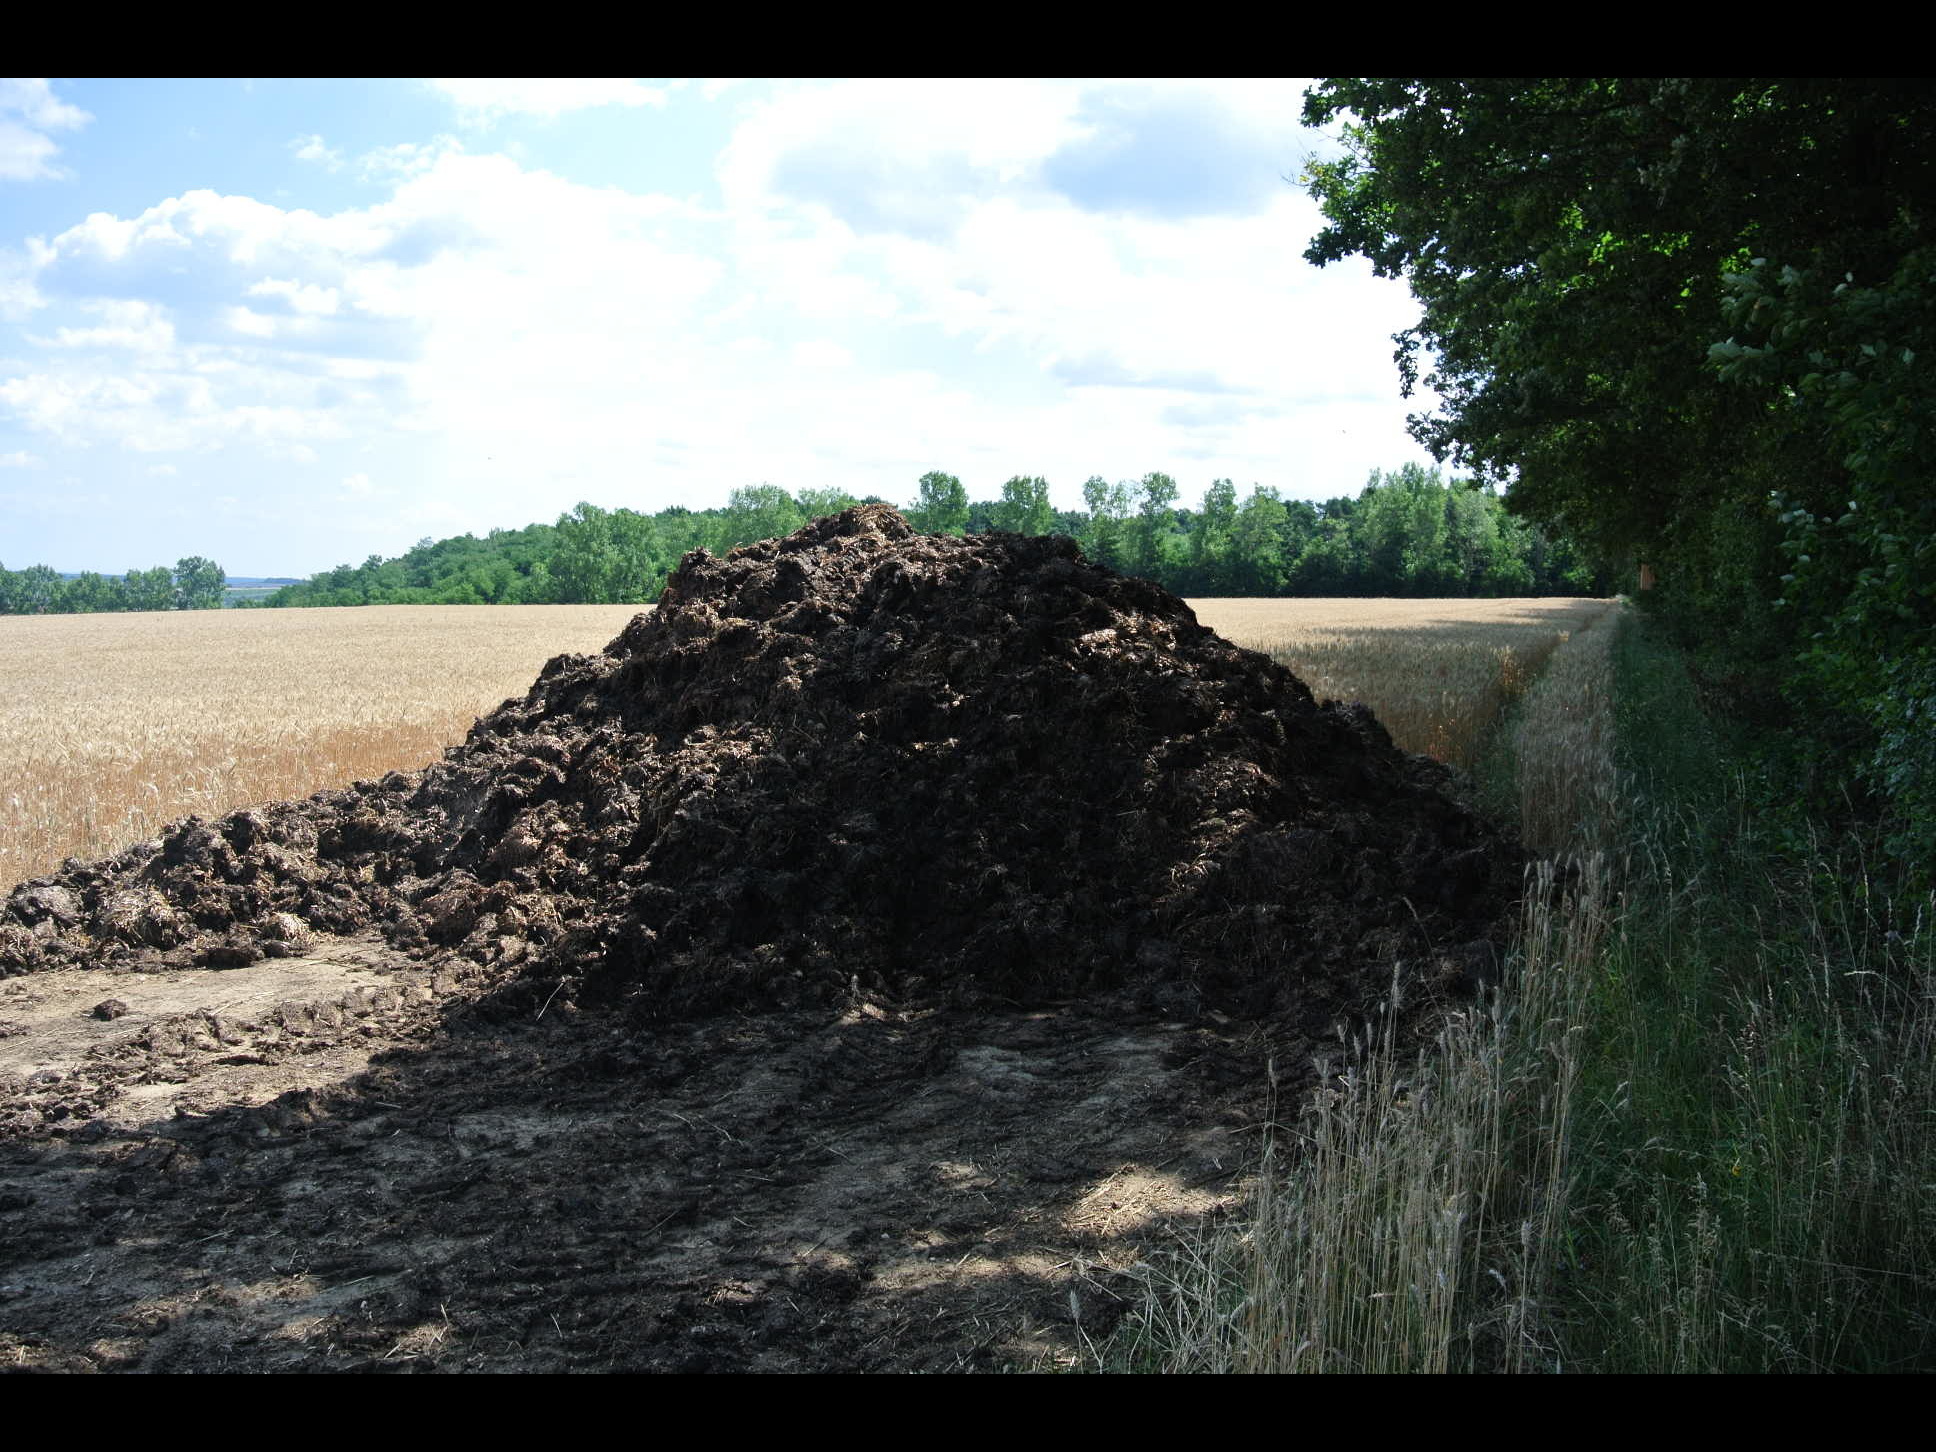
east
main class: Grassland
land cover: Grassland without tree/shrub cover
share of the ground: > 75 %
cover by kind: herbaceous plants 100 %
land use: Agriculture (excluding fallow land and kitchen gardens)
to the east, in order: Grassland without tree/shrub cover; Common wheat
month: July
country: AT
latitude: 47.7444
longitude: 16.4728
